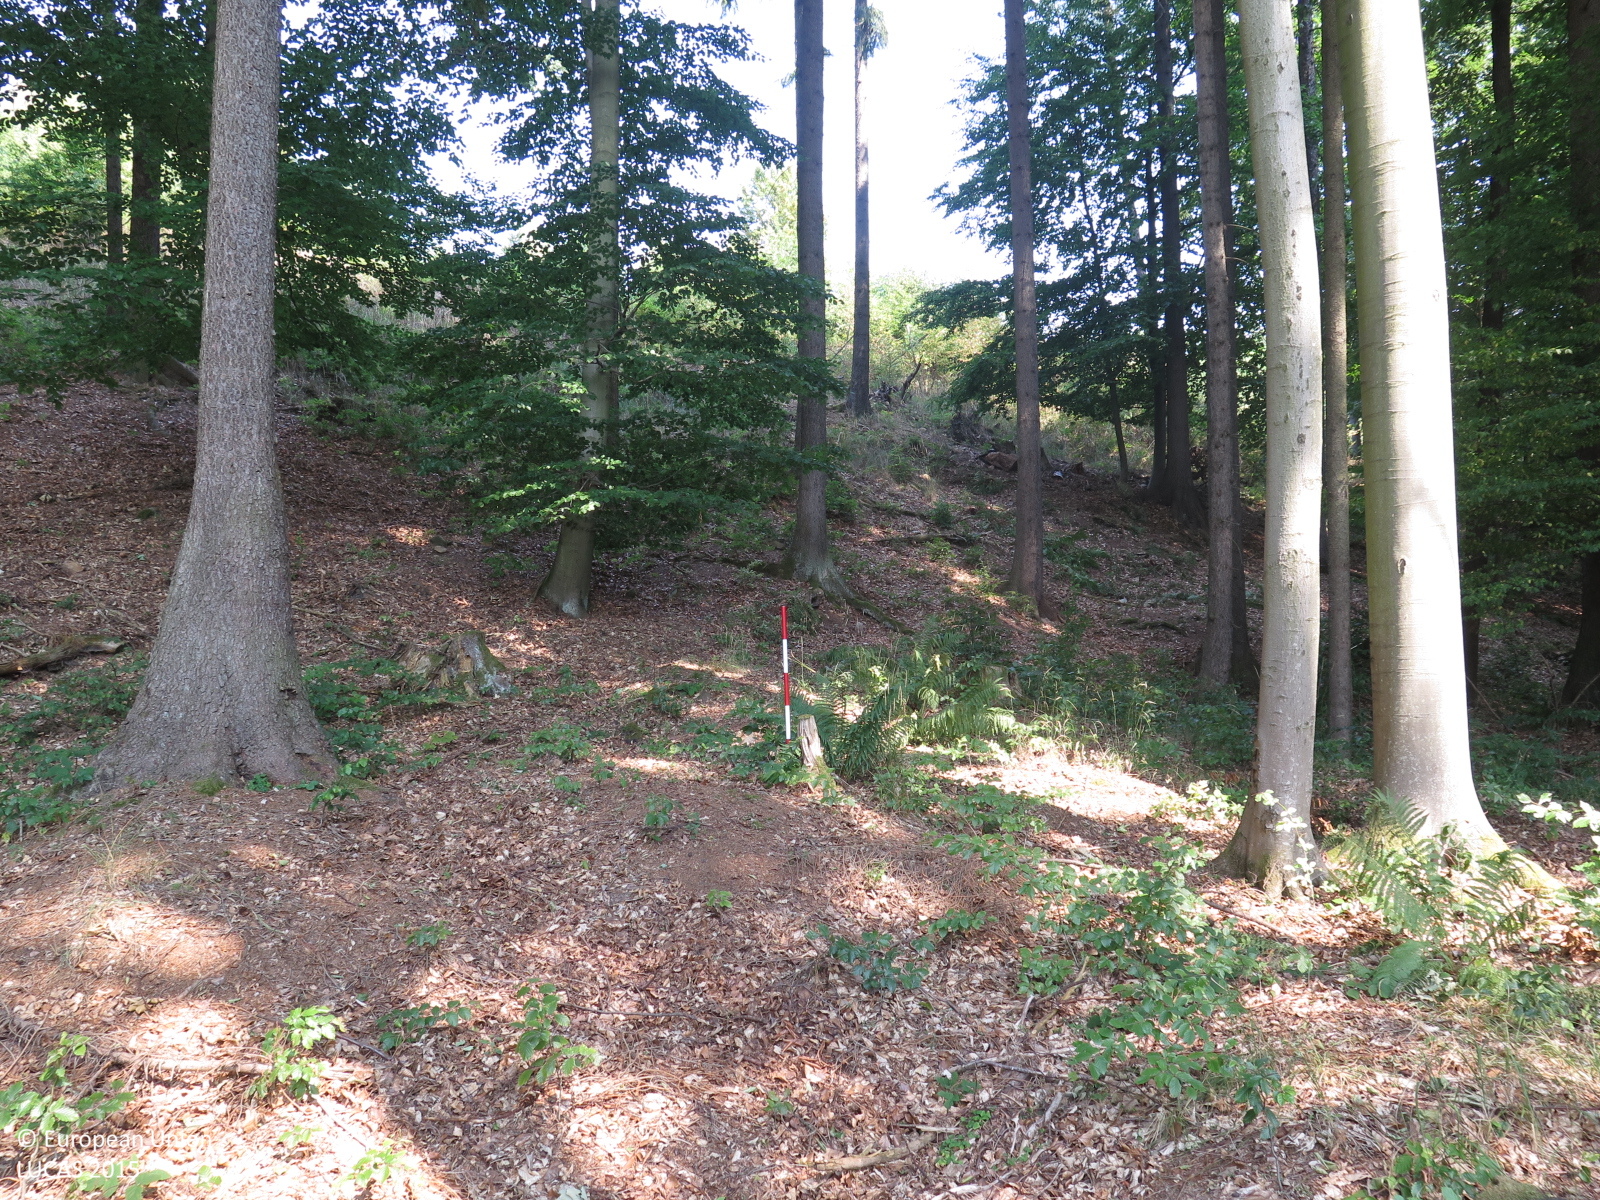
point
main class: Woodland
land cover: Spruce dominated mixed woodland
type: hemiboreal forest and nemoral coniferous forest and mixed broadleaved-coniferous forest
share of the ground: > 75 %
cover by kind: coniferous forest trees 65 %, broadleaved forest trees 30 %, herbaceous plants 5 %
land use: Forestry
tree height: > 5 m
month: August
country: CZ
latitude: 49.9219
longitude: 13.8310
